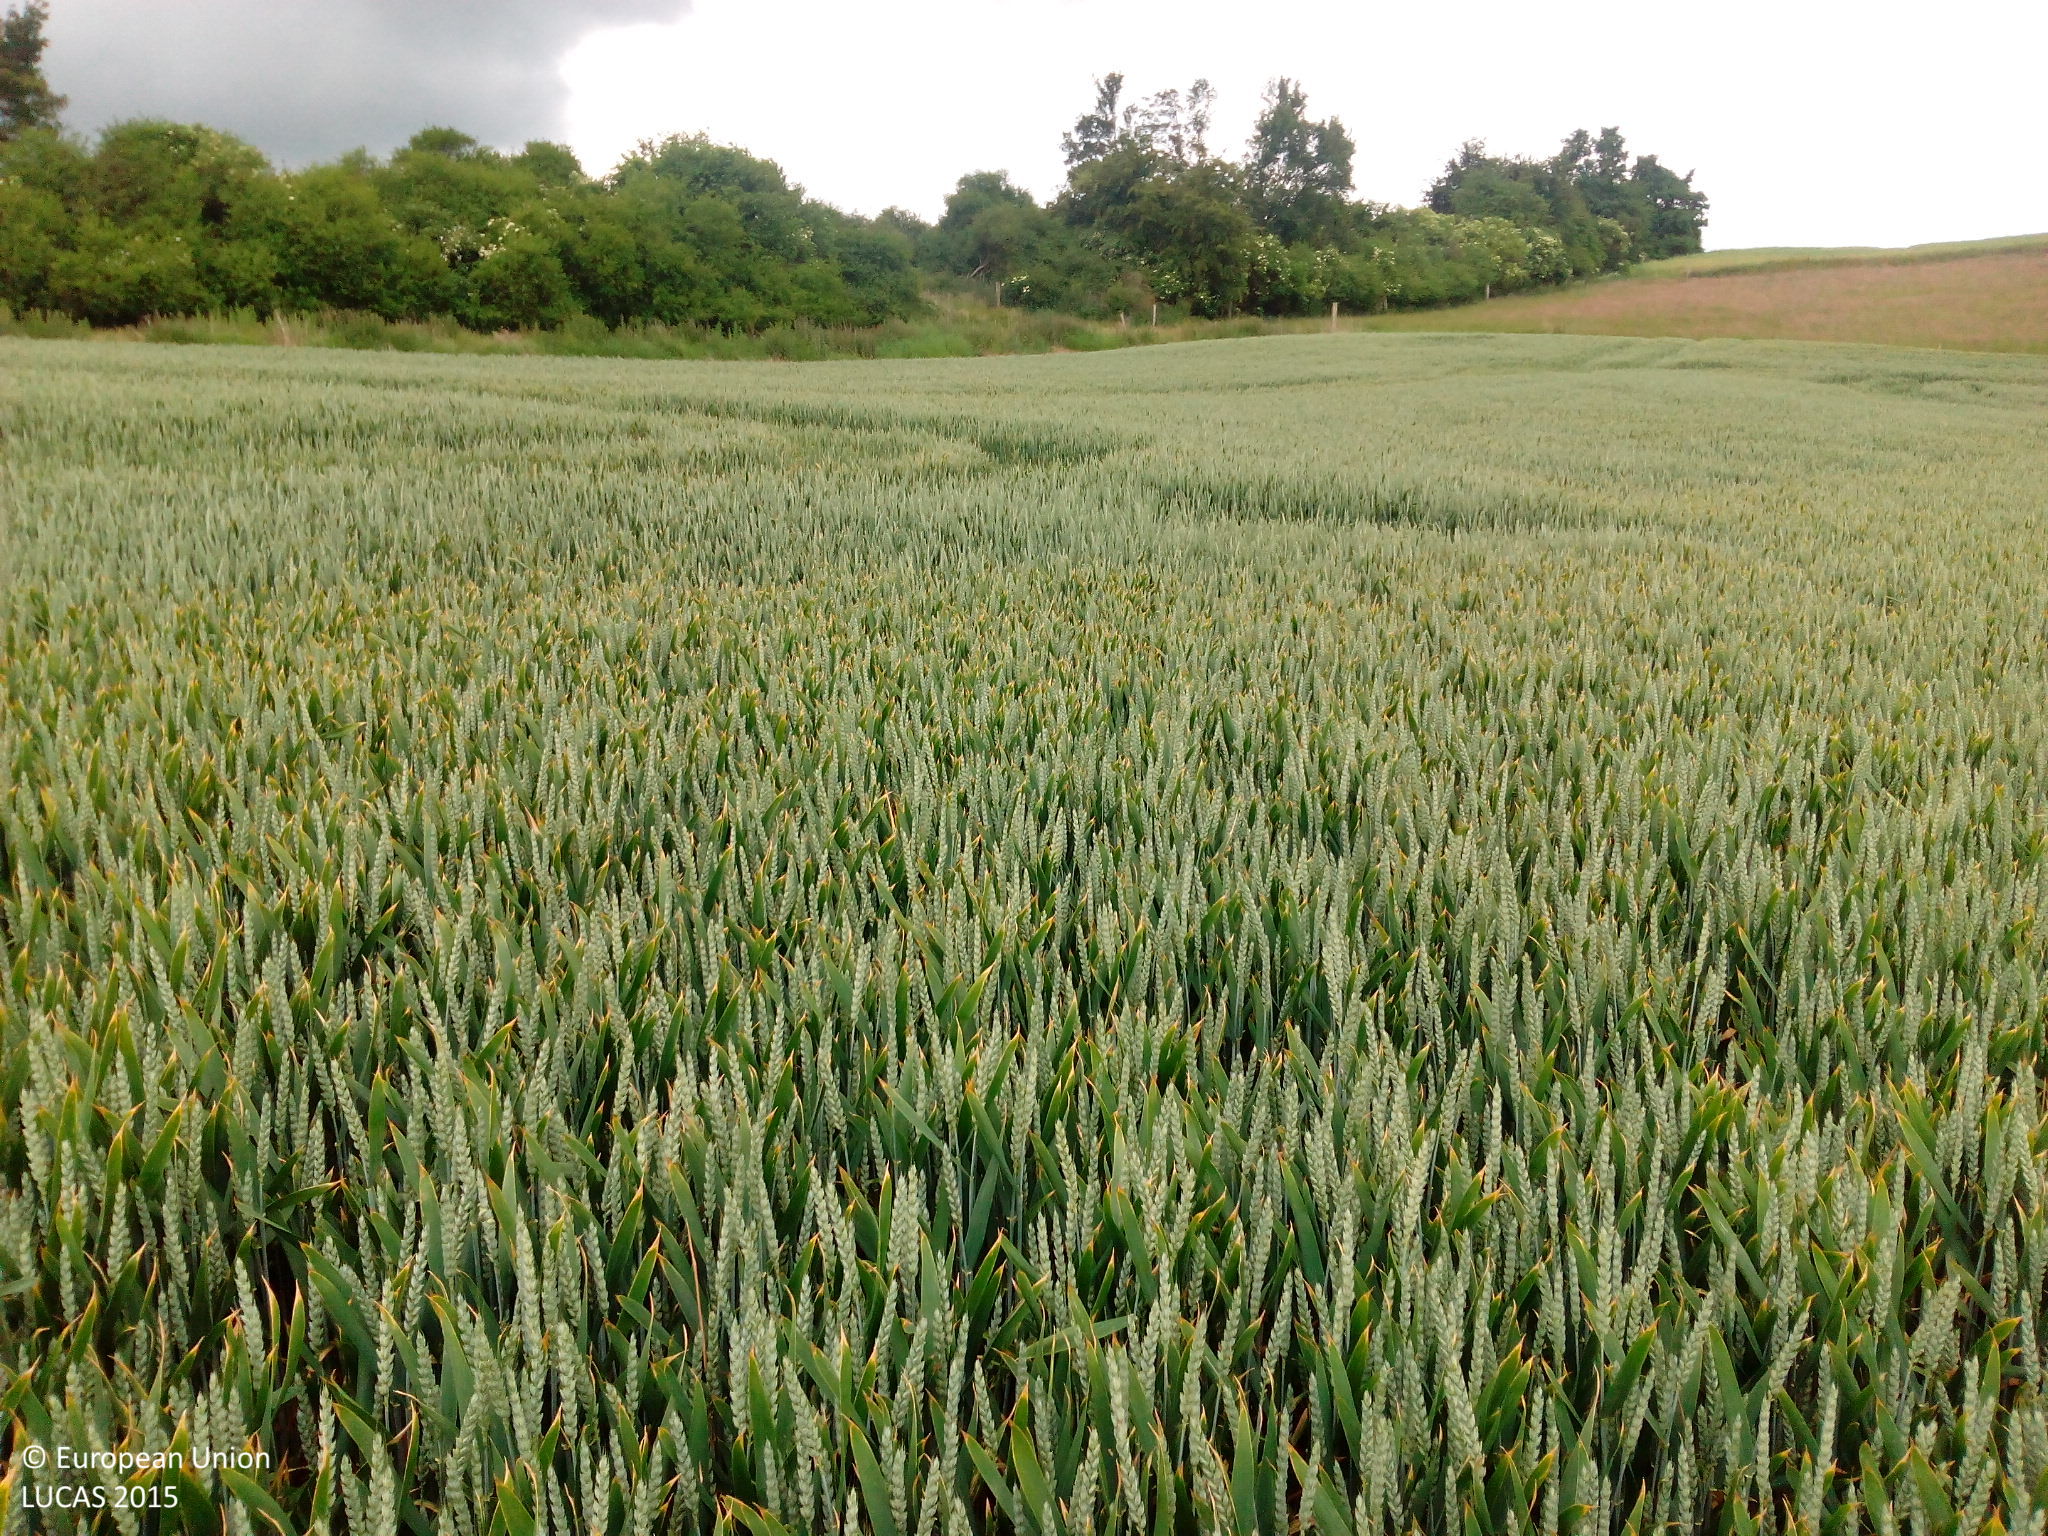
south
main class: Cropland
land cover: Common wheat
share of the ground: > 75 %
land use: Agriculture (excluding fallow land and kitchen gardens)
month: June
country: DE
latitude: 53.8105
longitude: 11.0777
